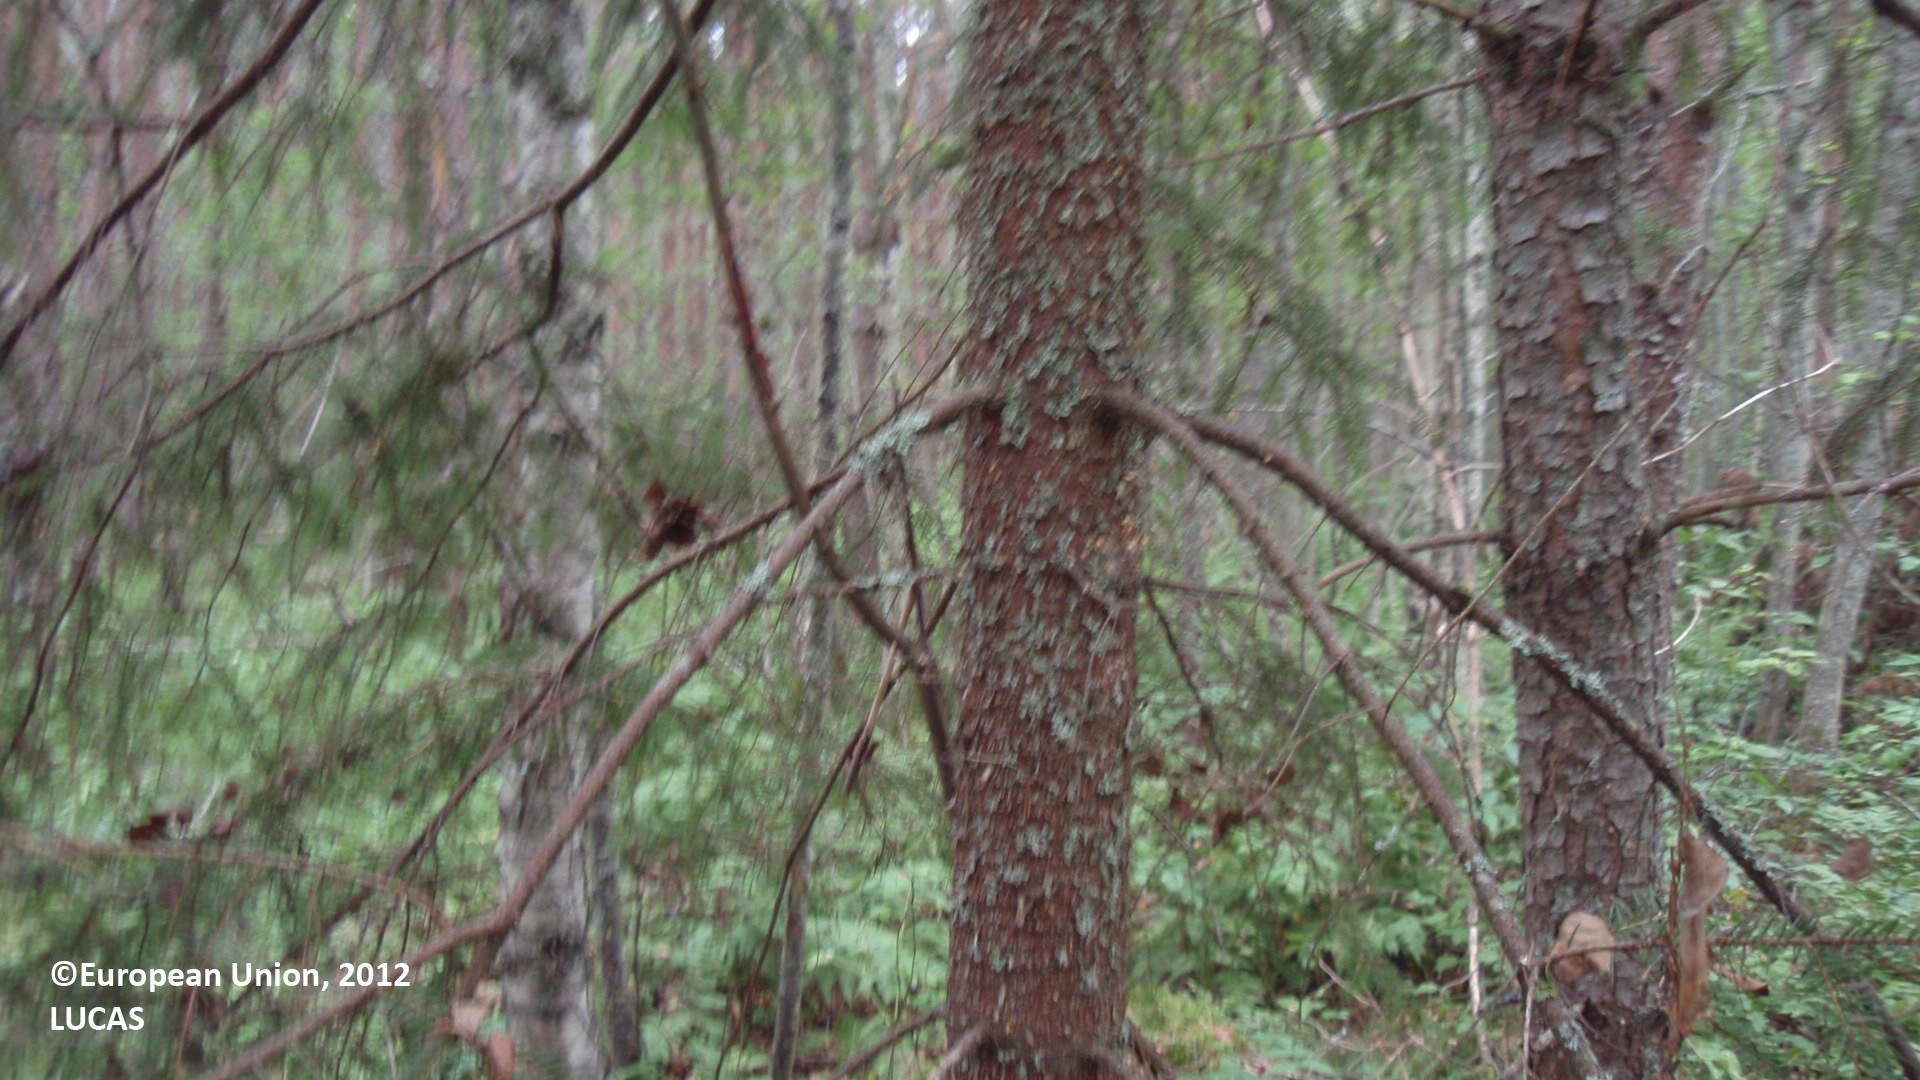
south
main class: Woodland
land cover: Pine dominated mixed woodland
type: boreal forest
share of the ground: > 75 %
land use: Forestry
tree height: > 5 m
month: August
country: FI
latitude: 61.0890
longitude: 27.6729
